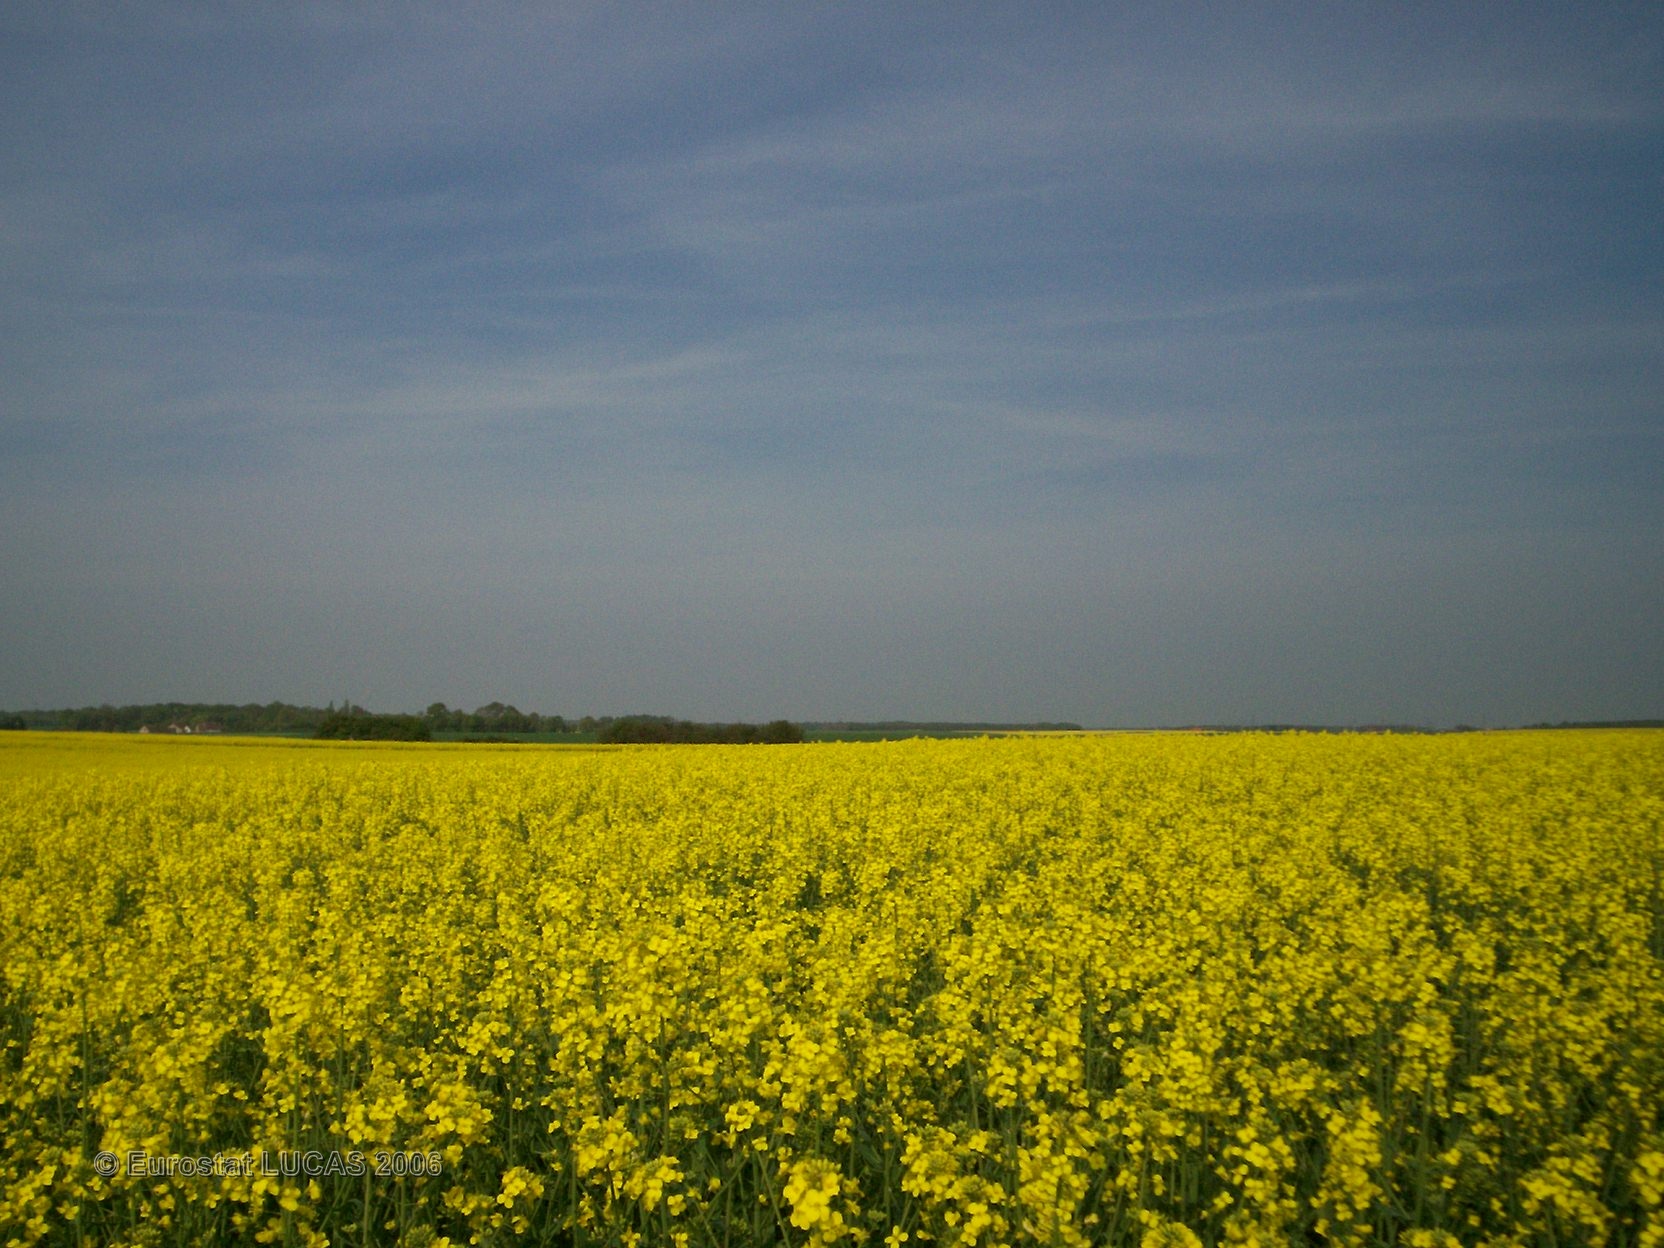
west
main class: Cropland
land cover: Rape and turnip rape
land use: Agriculture (excluding fallow land and kitchen gardens)
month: May
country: FR
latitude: 48.0859
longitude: 2.9175
